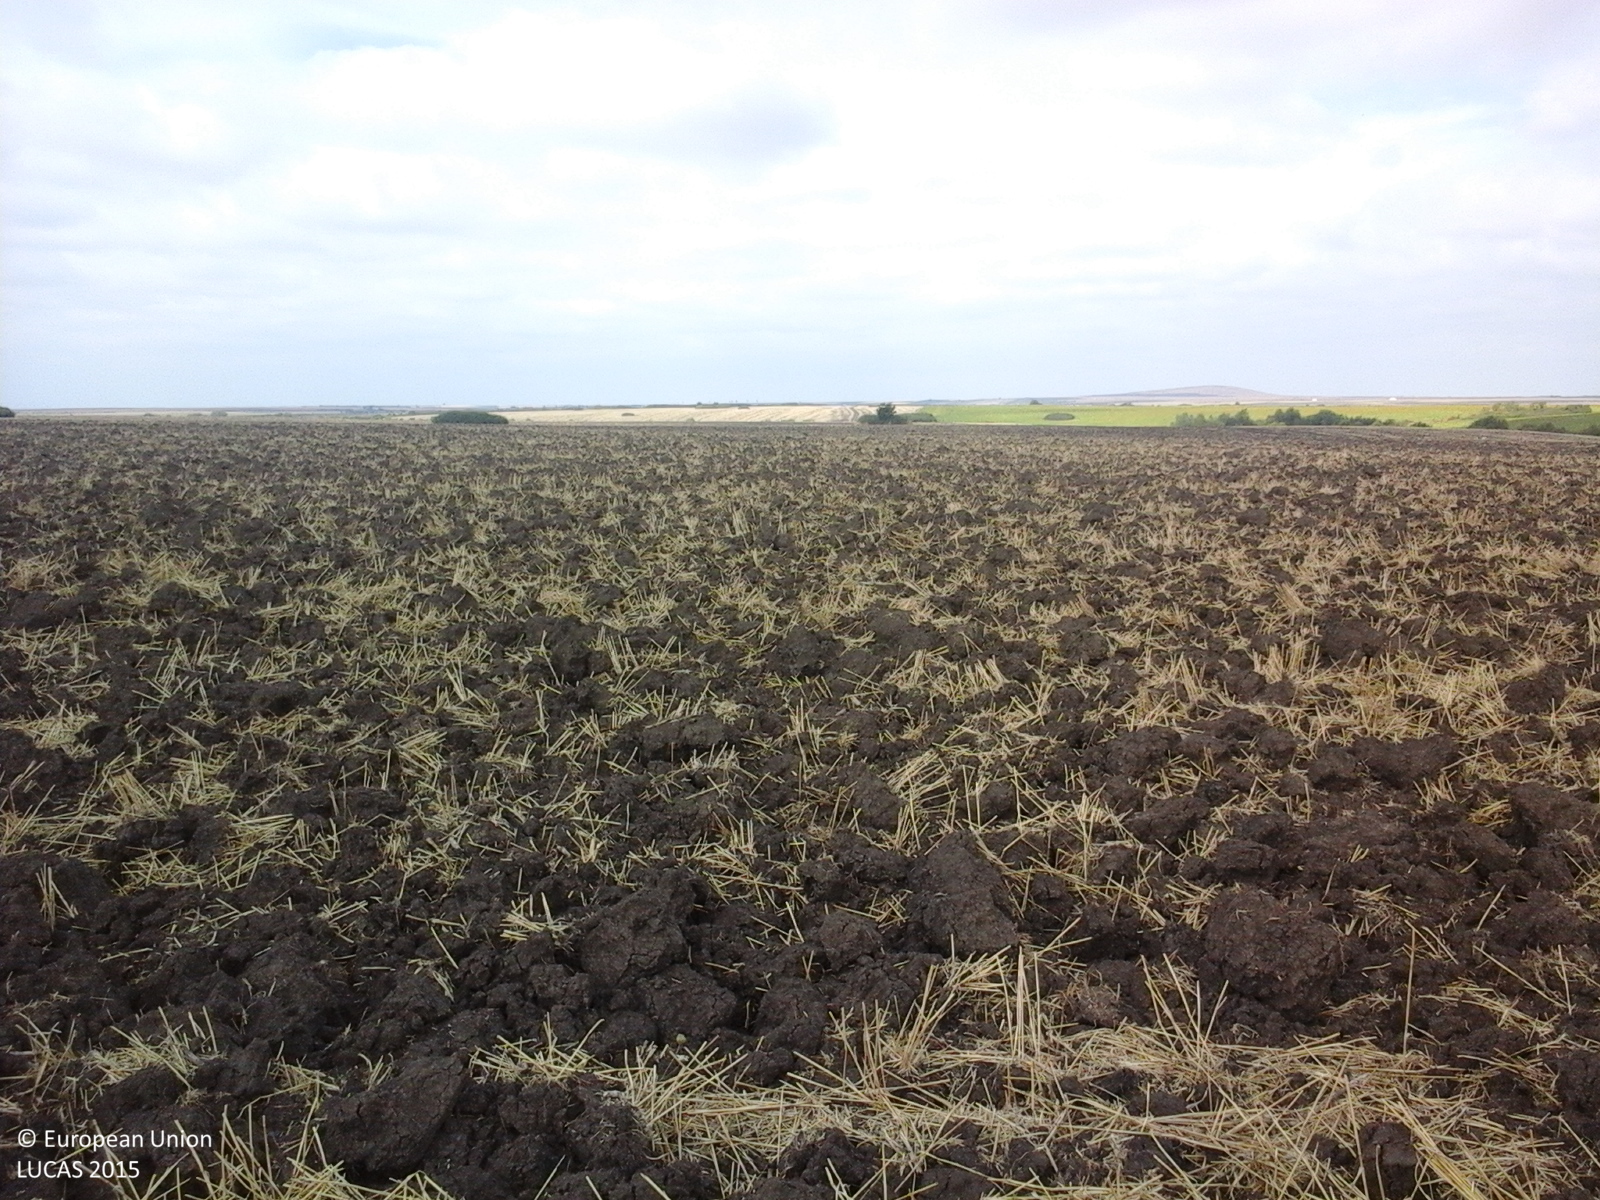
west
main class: Cropland
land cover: Common wheat
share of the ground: < 10 %
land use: Agriculture (excluding fallow land and kitchen gardens)
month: August
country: RO
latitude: 45.3640
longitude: 21.5090
